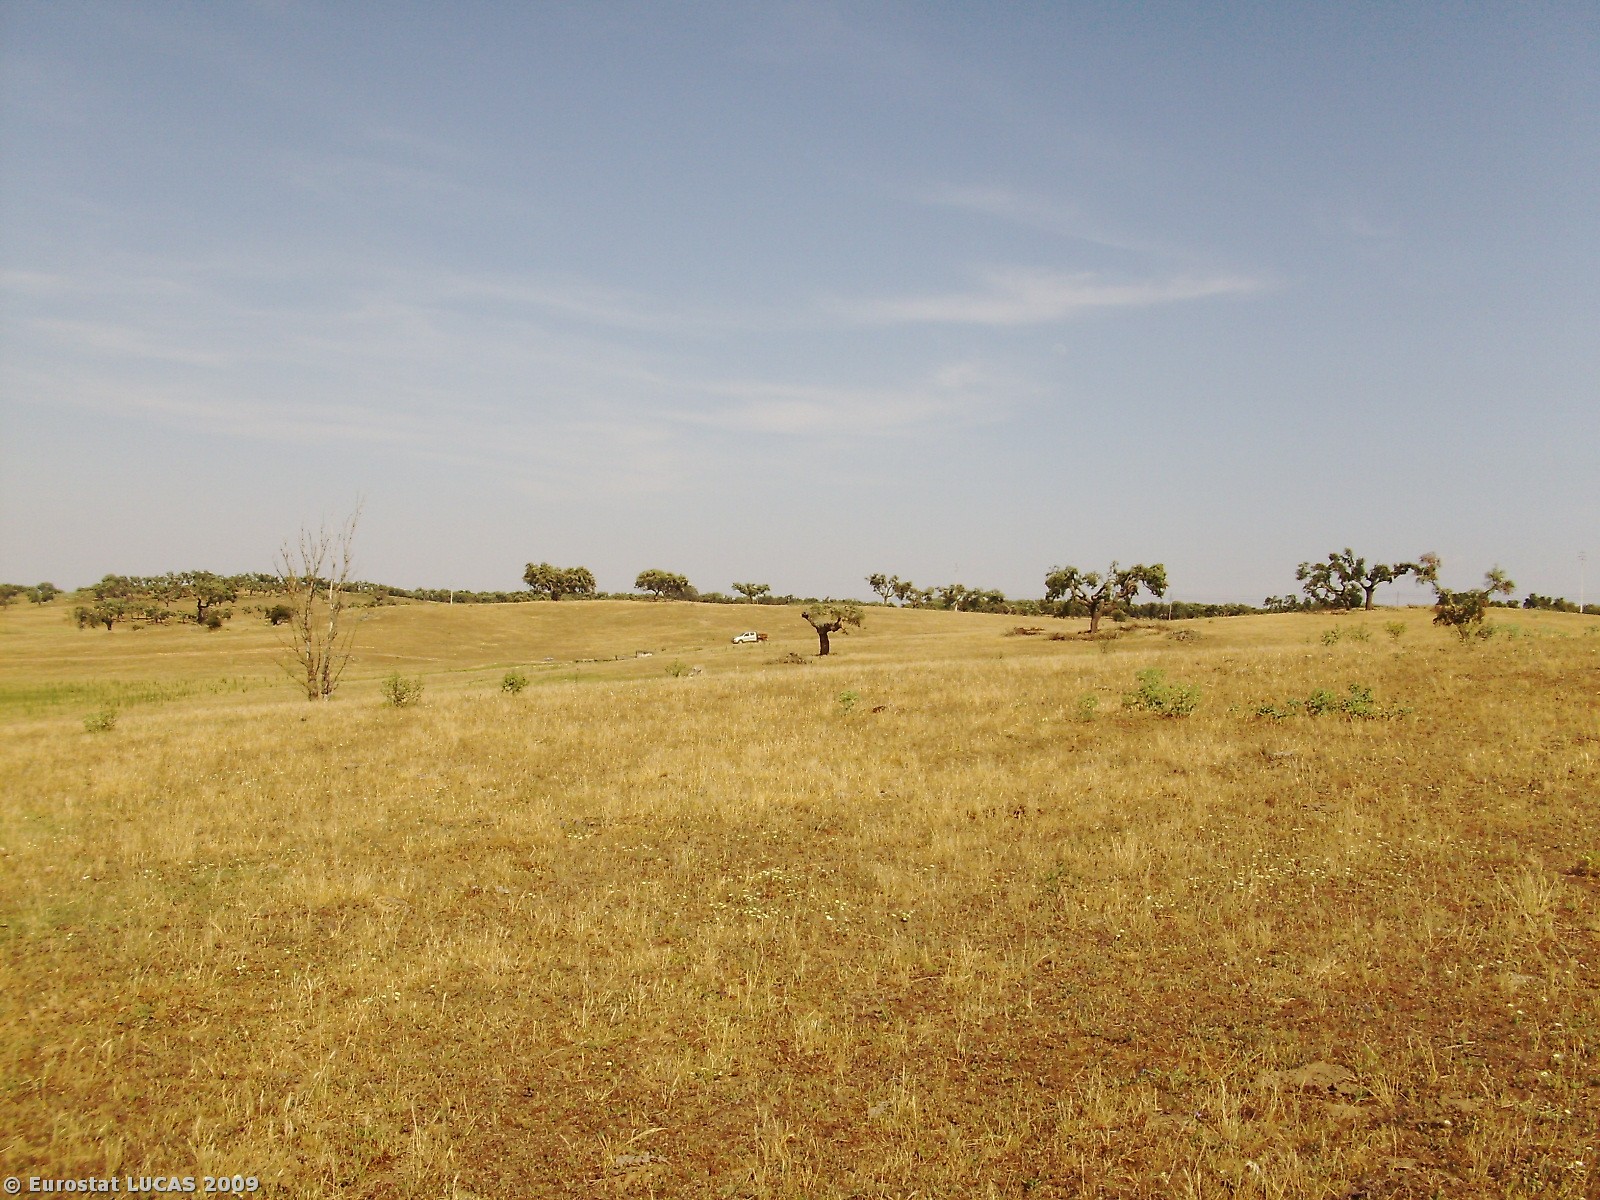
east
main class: Grassland
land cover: Grassland without tree/shrub cover
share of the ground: > 75 %
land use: Agriculture (excluding fallow land and kitchen gardens)
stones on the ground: 10 - 25 %
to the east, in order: Grassland without tree/shrub cover; Rivers and streams; Grassland without tree/shrub cover; Tracks; Grassland without tree/shrub cover
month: June
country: PT
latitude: 39.0667
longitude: -7.4079
